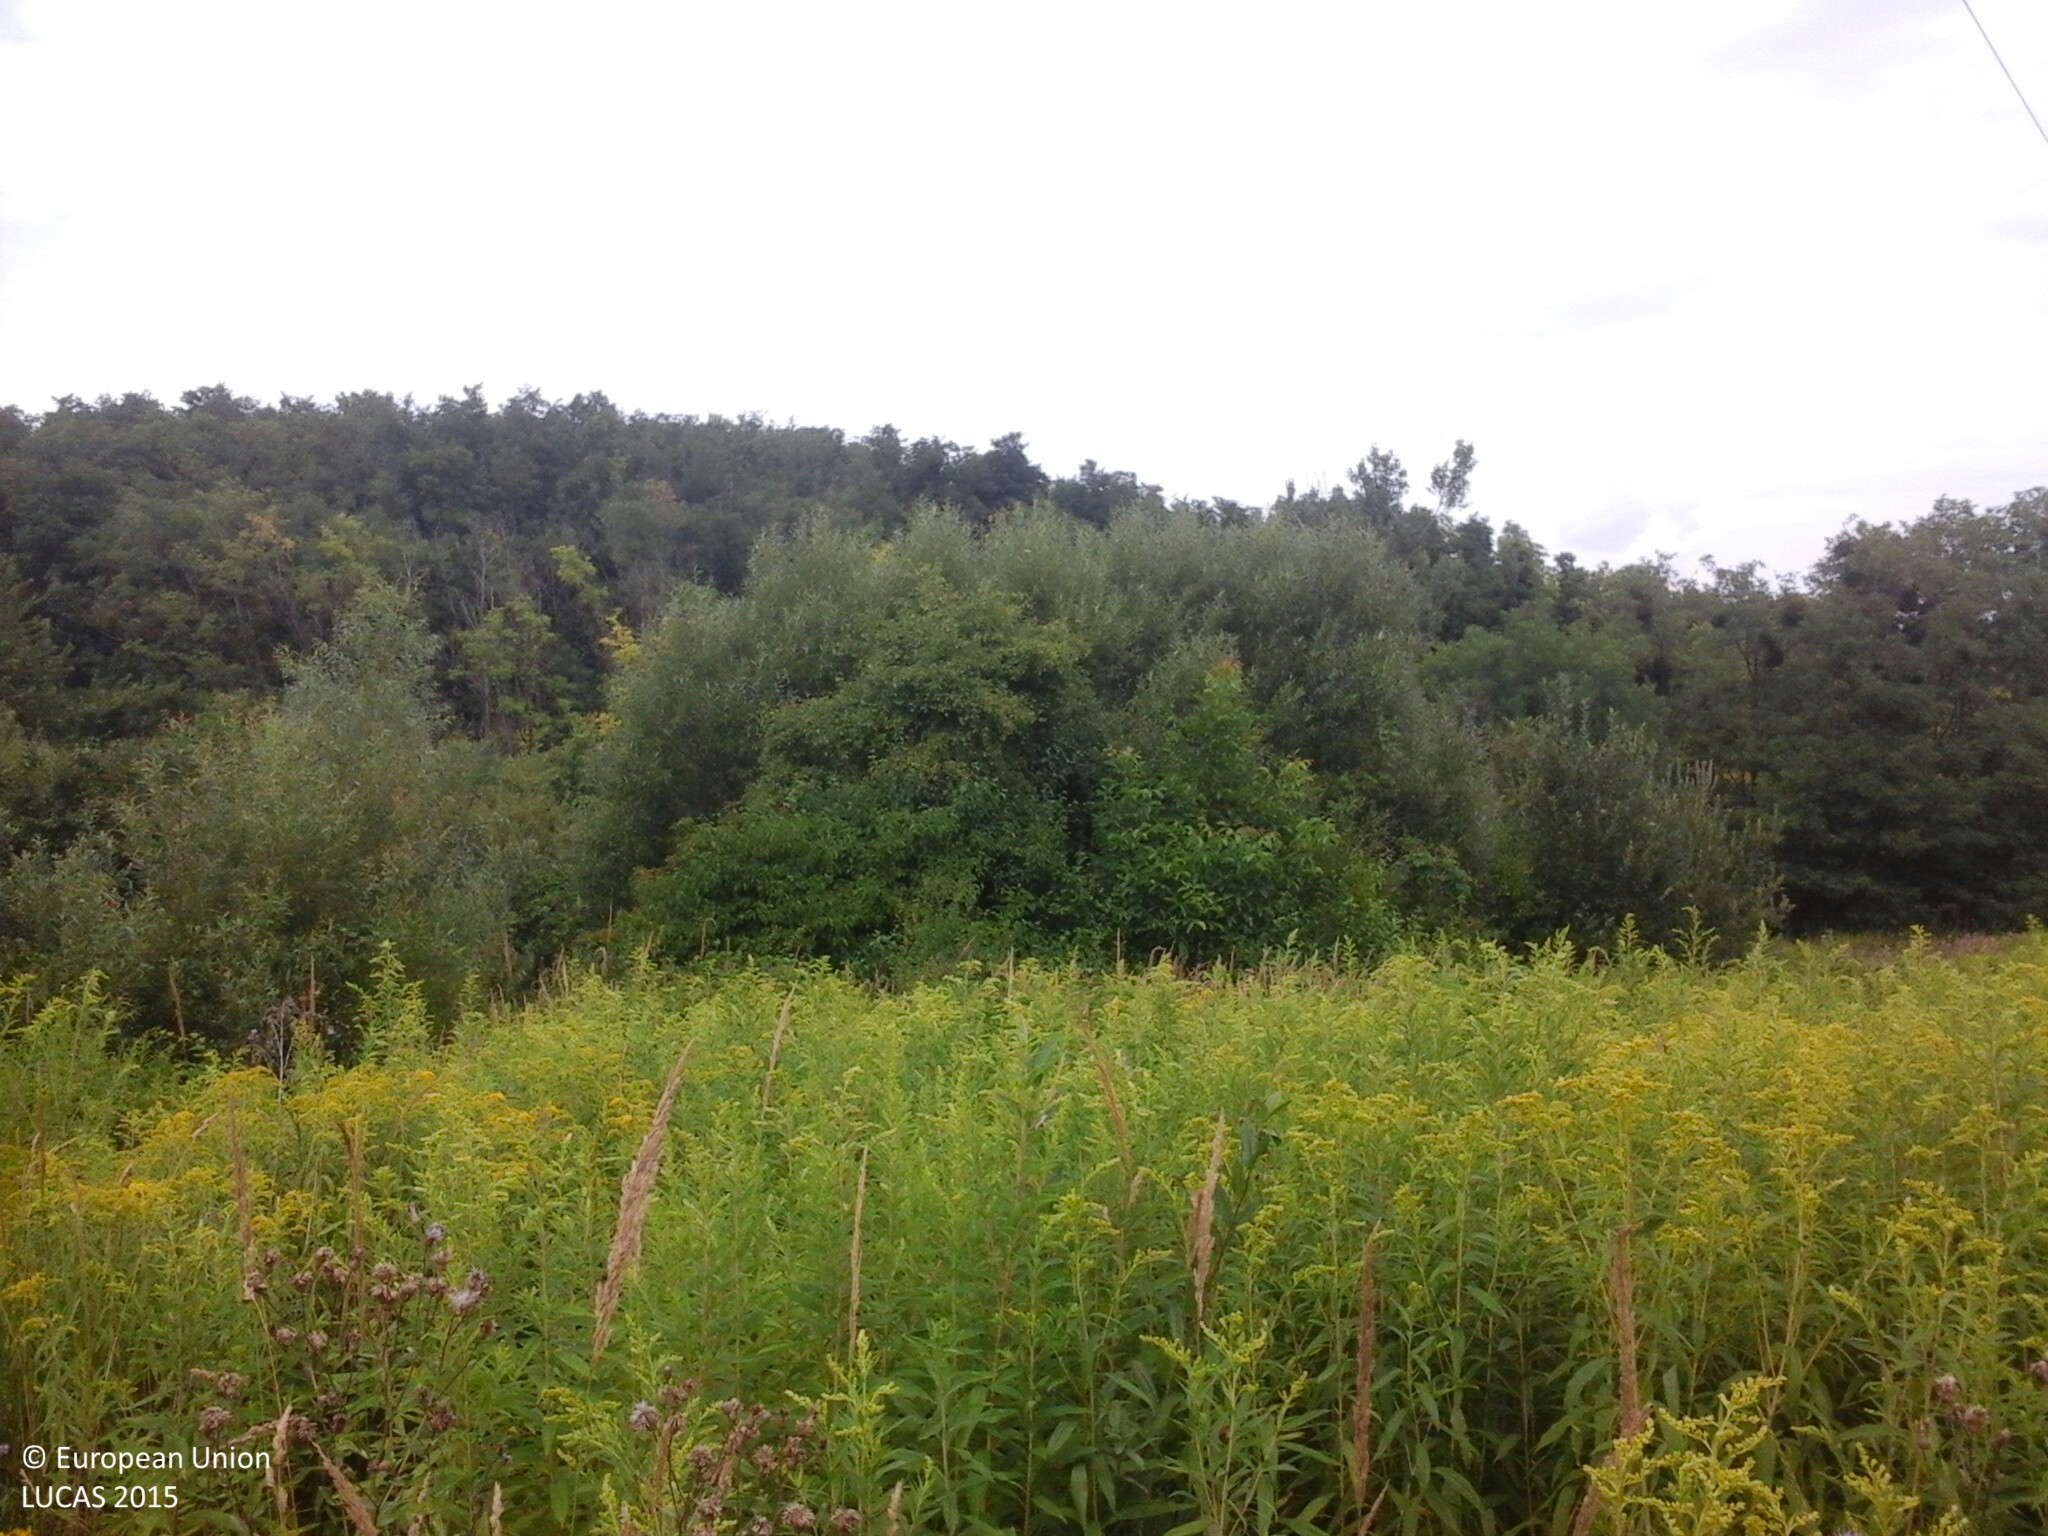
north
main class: Grassland
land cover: Spontaneously vegetated surfaces
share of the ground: > 75 %
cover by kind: herbaceous plants 100 %
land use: Semi-natural and natural areas not in use
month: July
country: HU
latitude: 47.3007
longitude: 17.9849
